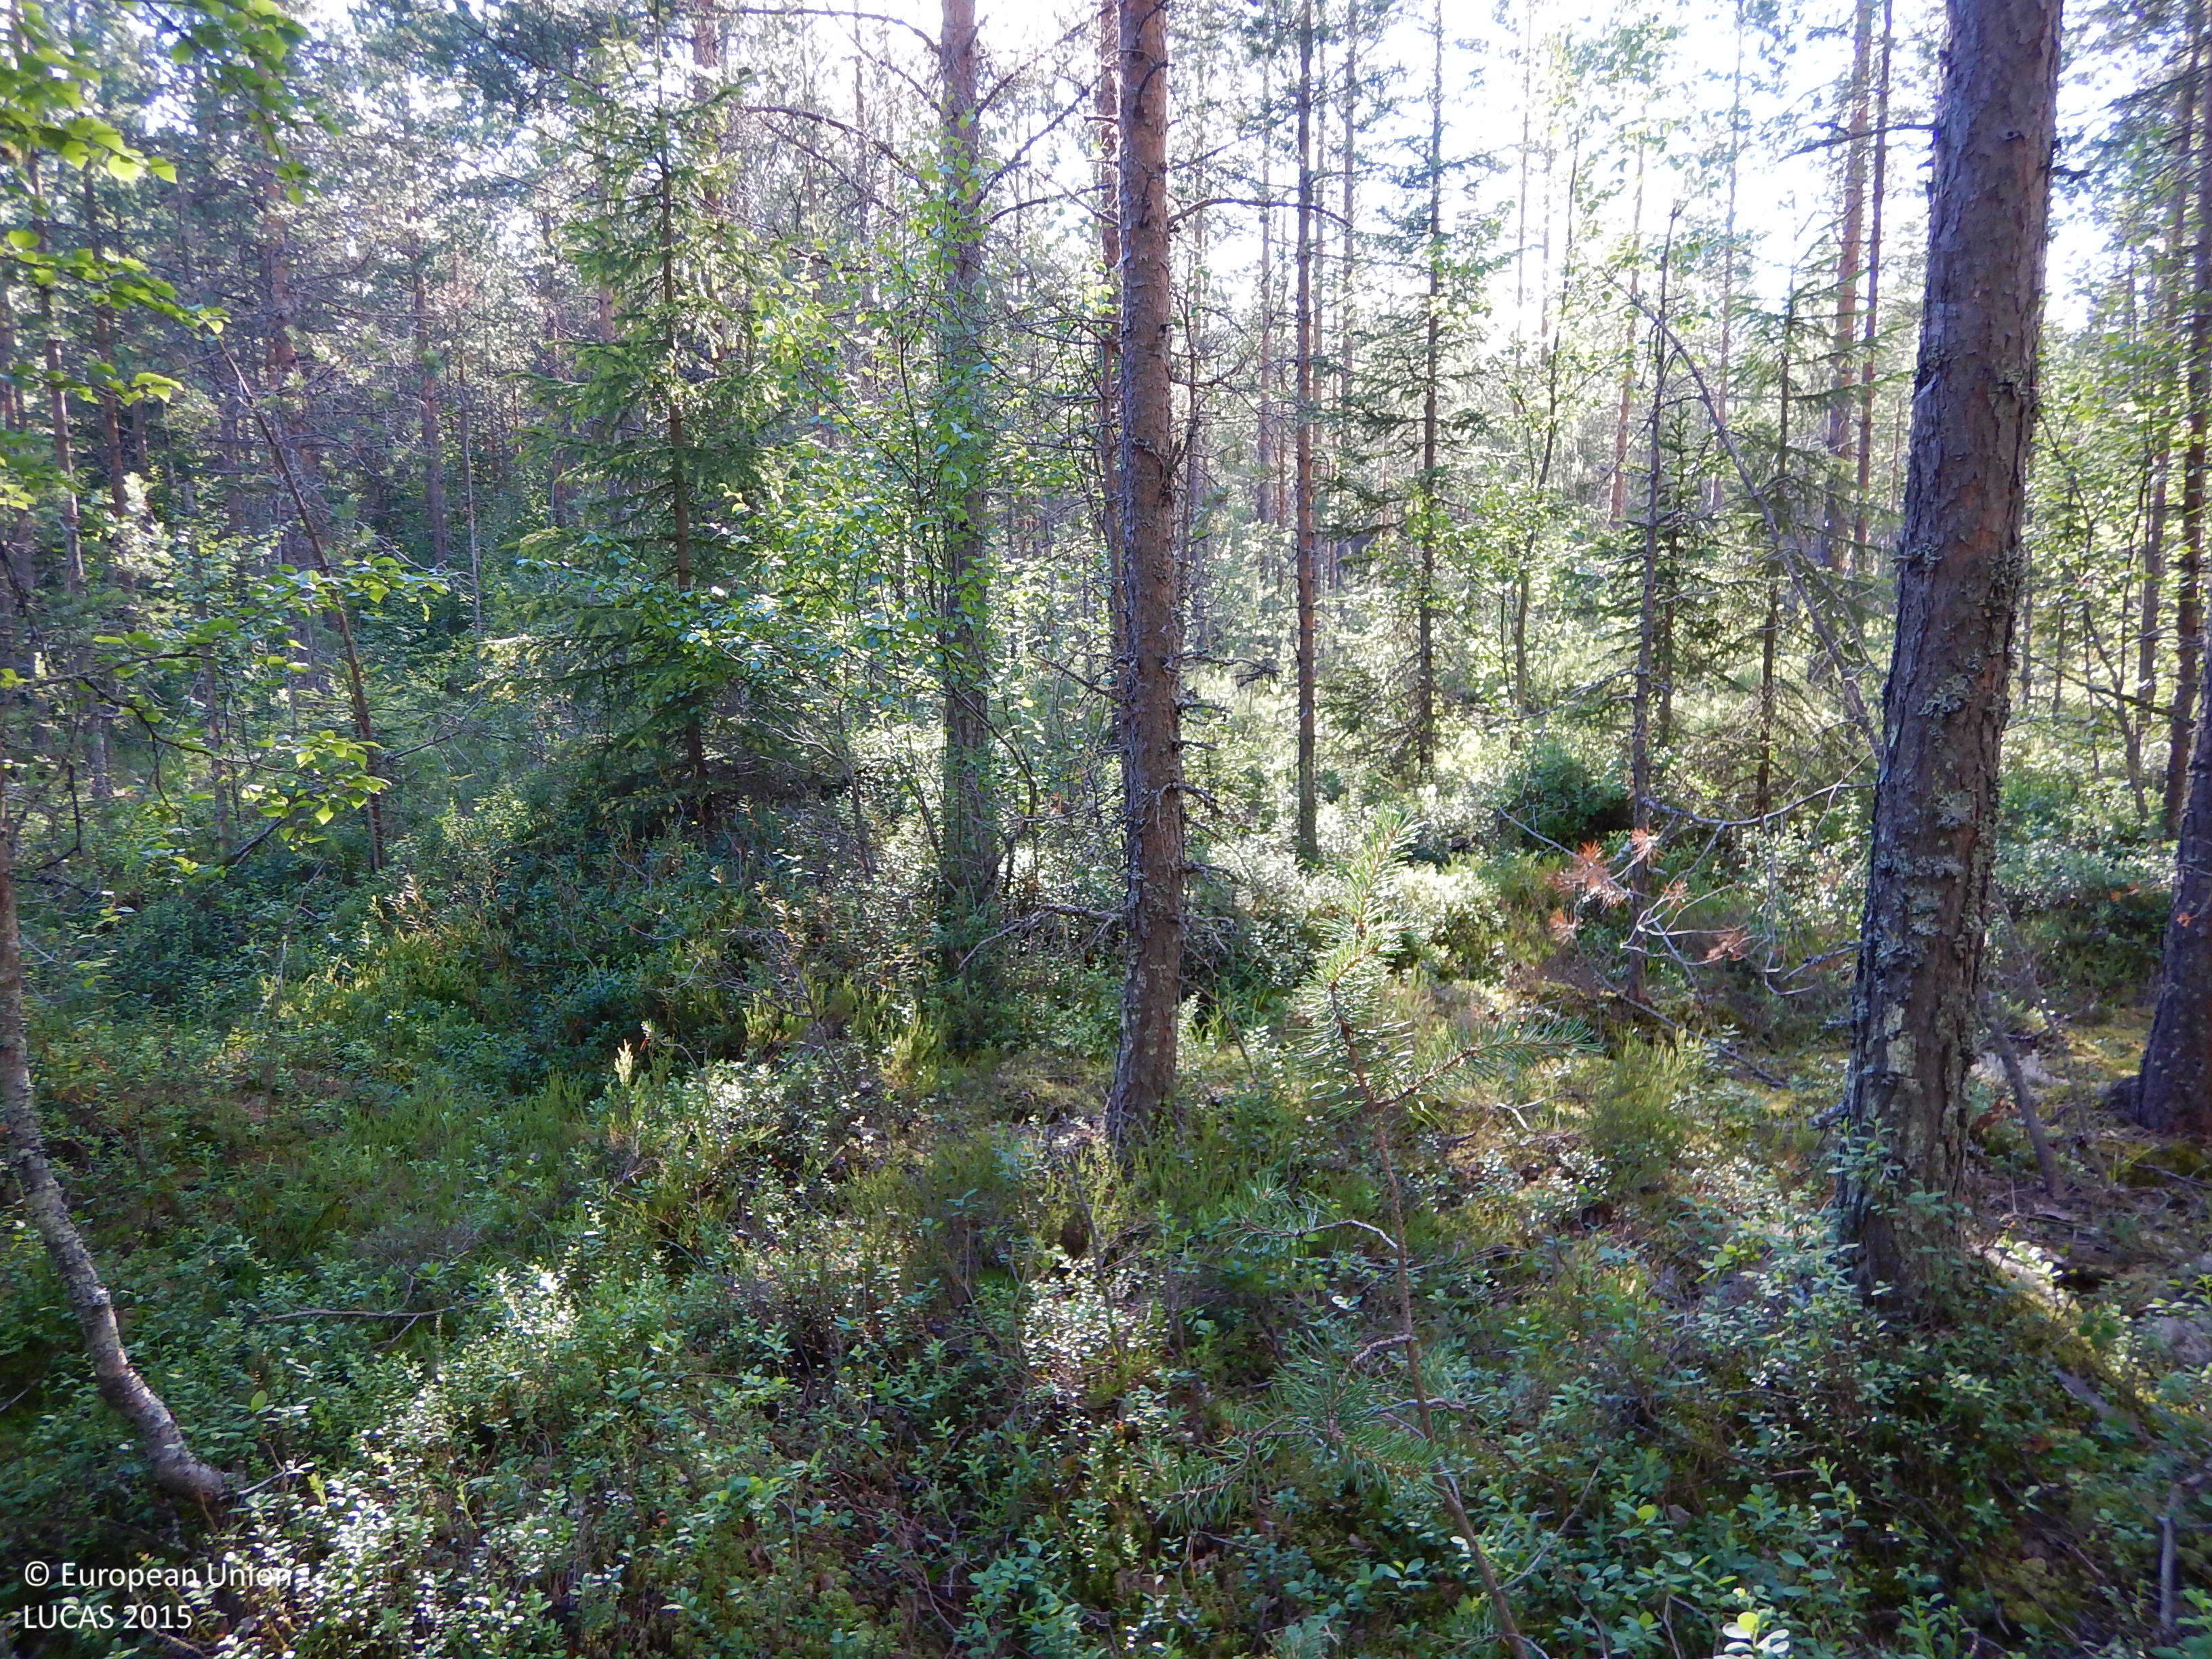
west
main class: Woodland
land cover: Pine dominated coniferous woodland
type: boreal forest
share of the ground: 50 - 75 %
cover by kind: coniferous forest trees 50 %, herbaceous plants 15 %, lichens and mosses 15 %, broadleaved forest trees 10 %, shrubs 10 %
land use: Forestry
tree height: > 5 m
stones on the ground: < 10 %
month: July
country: SE
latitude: 64.7865
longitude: 20.9388
